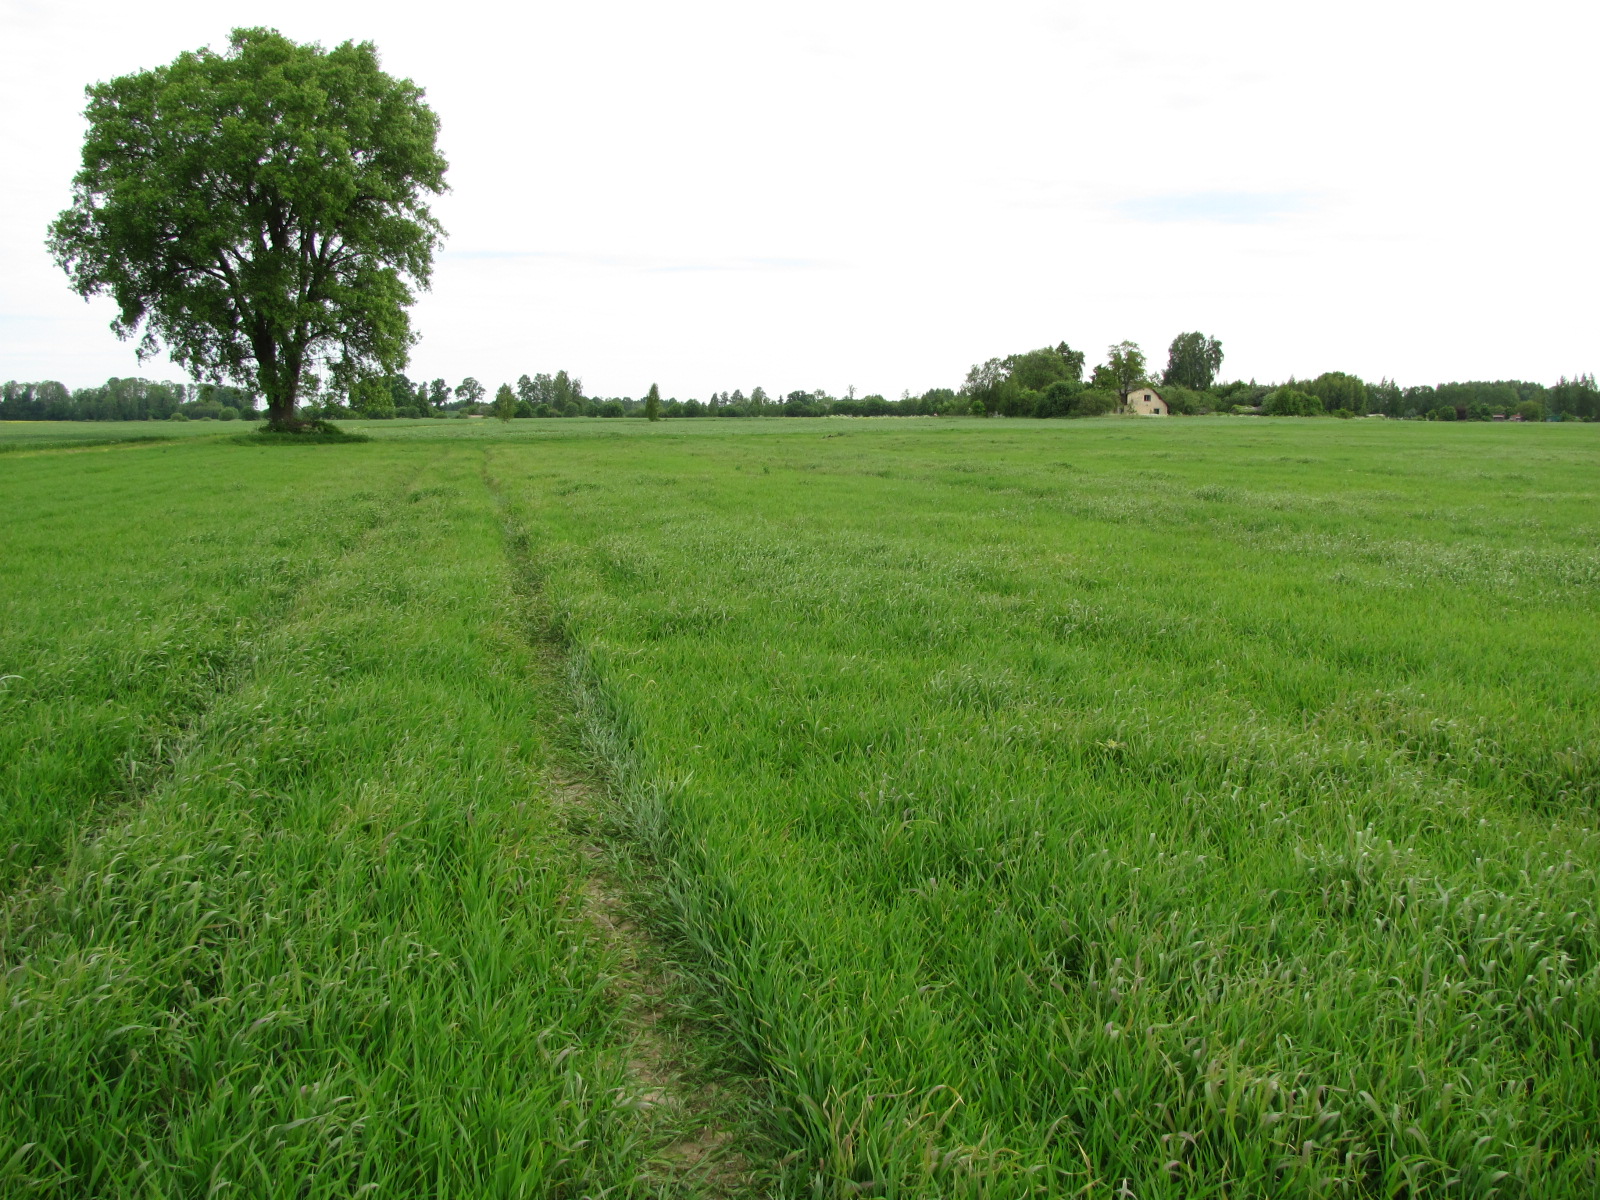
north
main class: Cropland
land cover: Common wheat
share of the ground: > 75 %
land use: Agriculture (excluding fallow land and kitchen gardens)
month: June
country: LV
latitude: 56.4370
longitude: 24.1831
